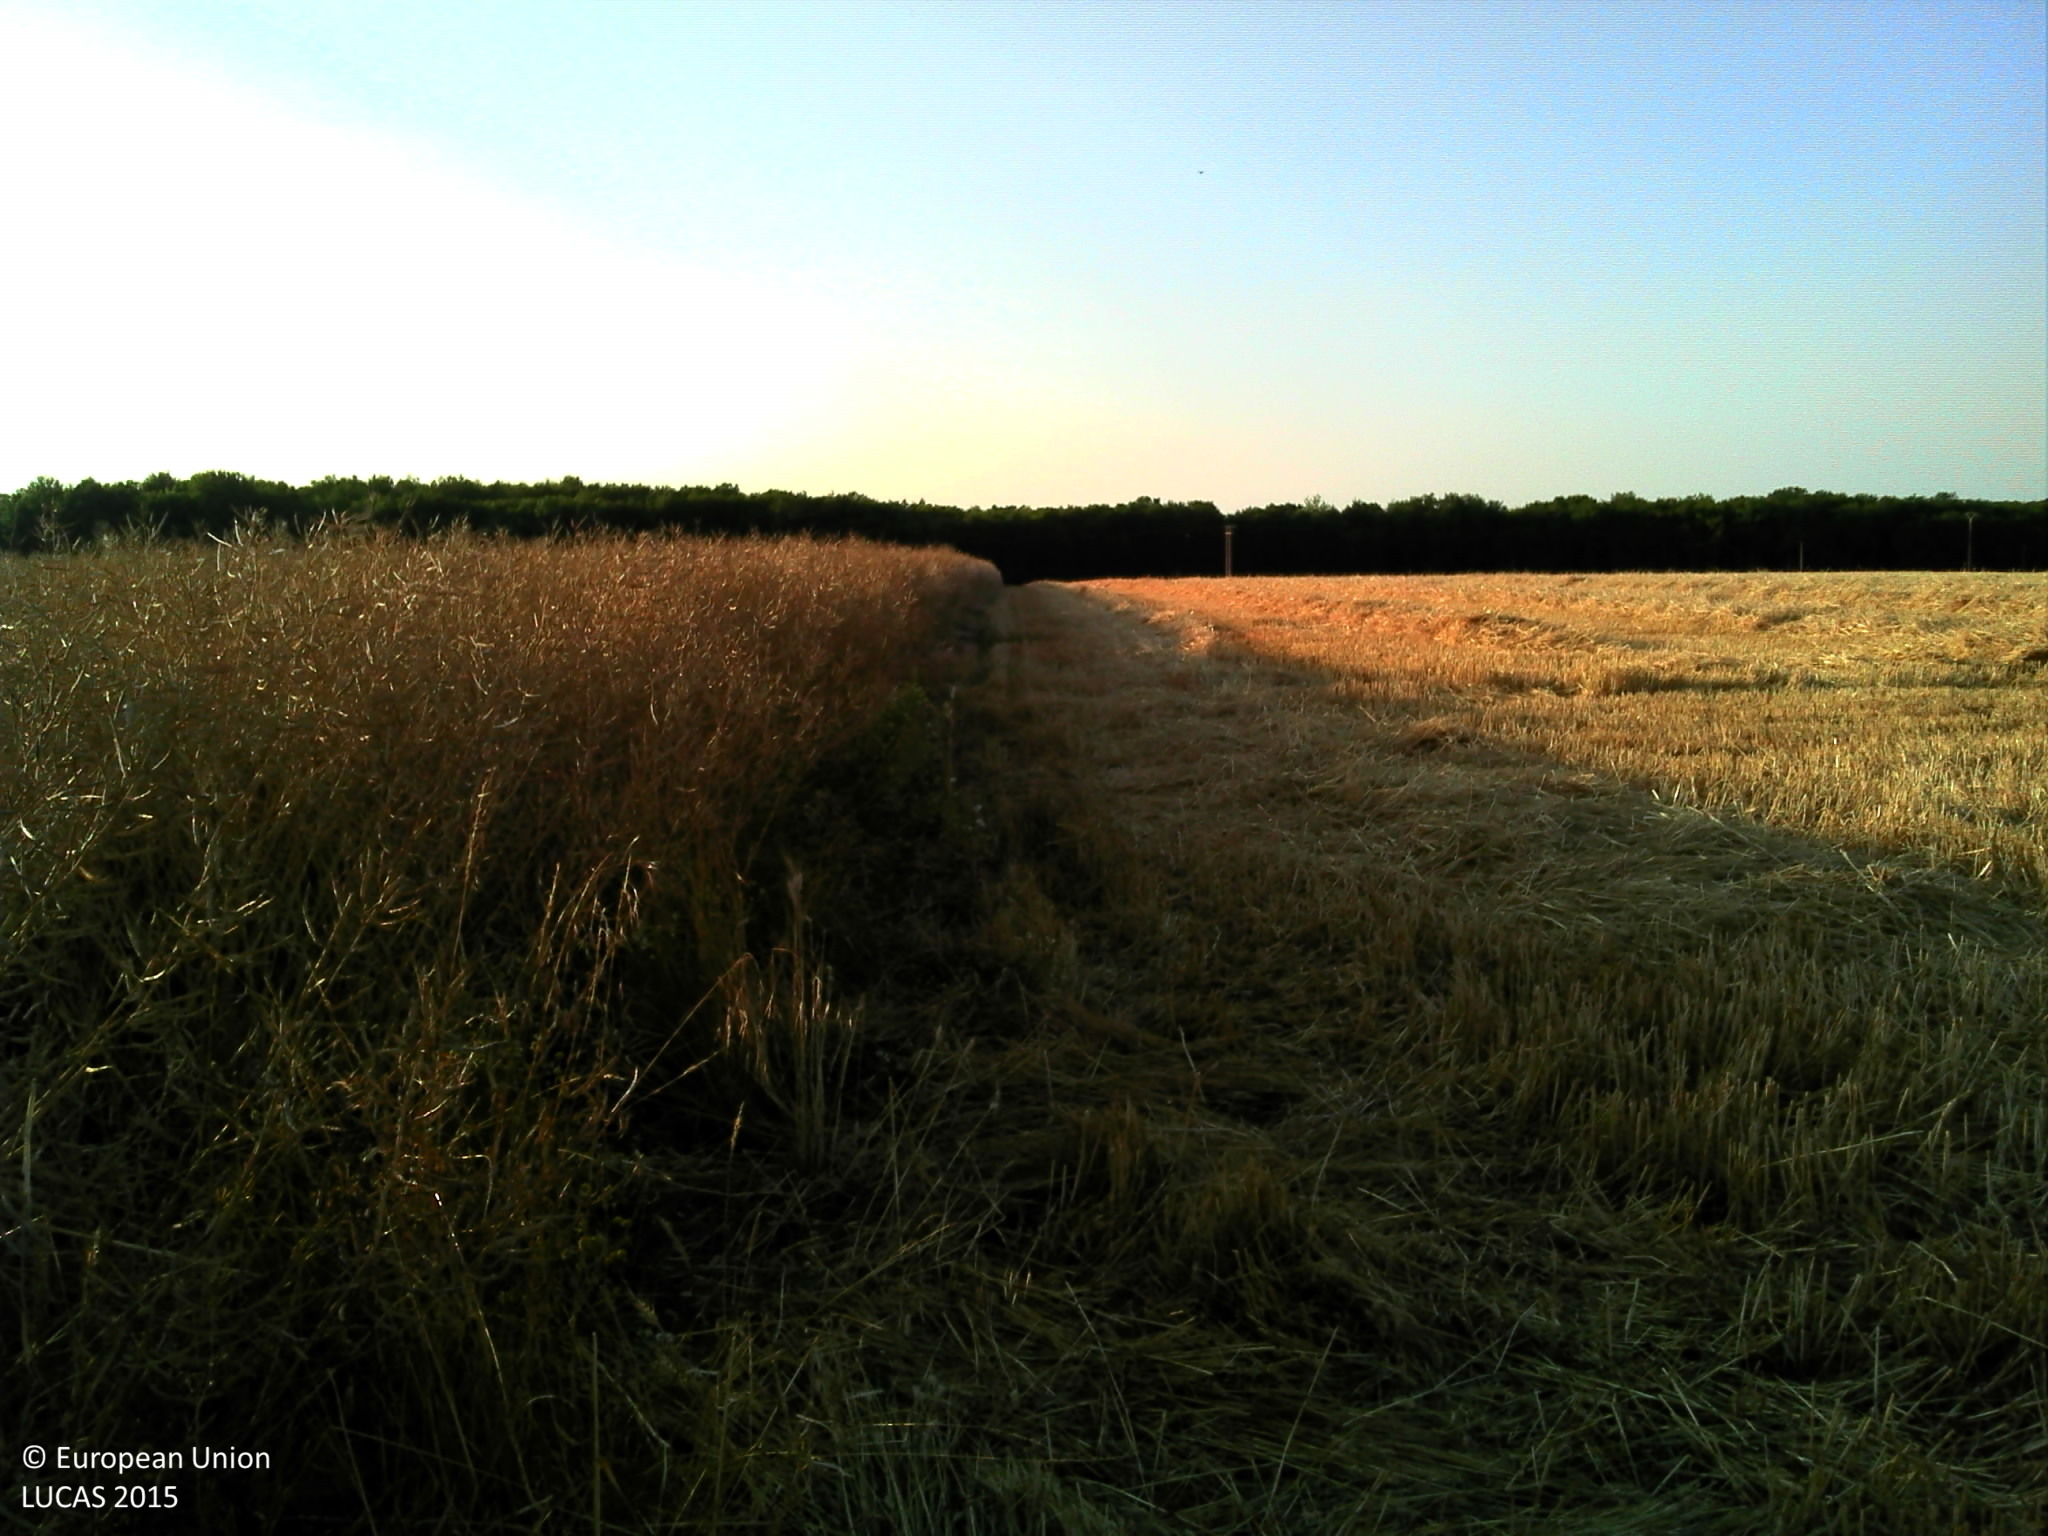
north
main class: Cropland
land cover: Rape and turnip rape
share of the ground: > 75 %
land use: Agriculture (excluding fallow land and kitchen gardens)
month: July
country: FR
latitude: 48.0366
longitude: 4.9695
